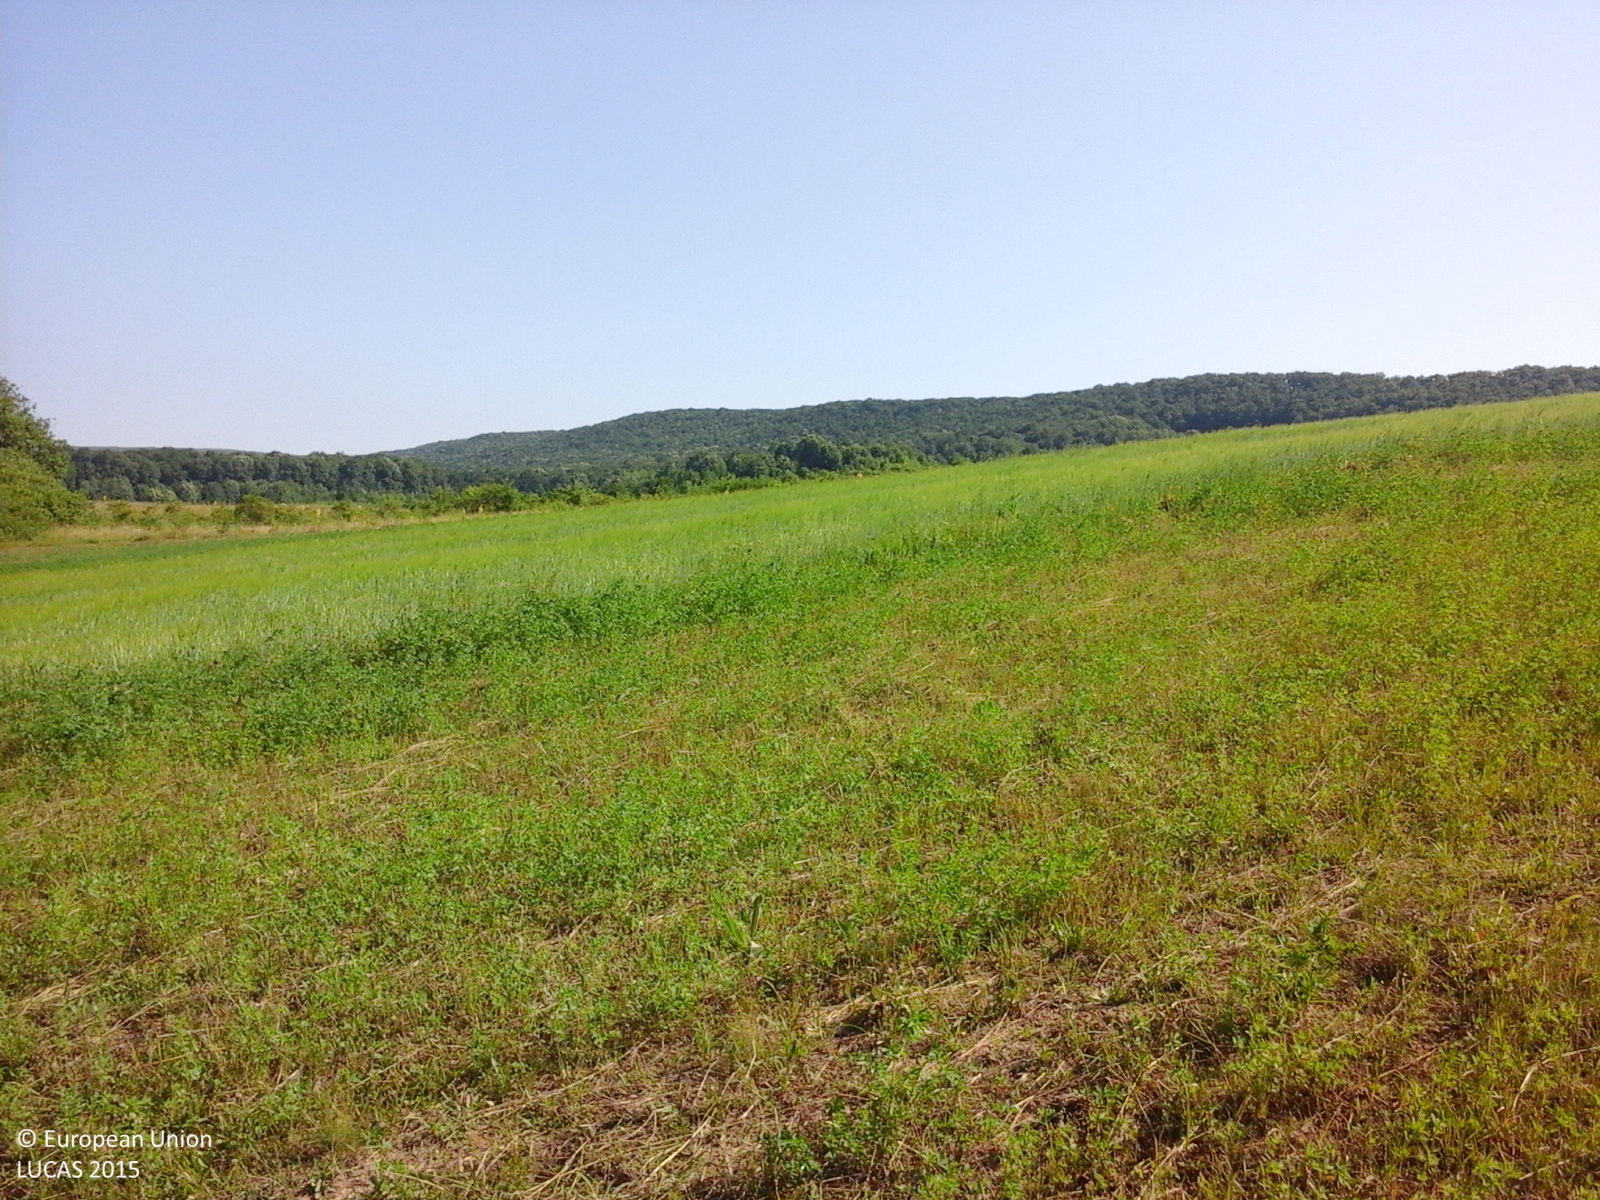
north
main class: Cropland
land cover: Other leguminous and mixtures for fodder
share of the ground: 10 - 25 %
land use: Agriculture (excluding fallow land and kitchen gardens)
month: June
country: RO
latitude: 46.5479
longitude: 27.6301
